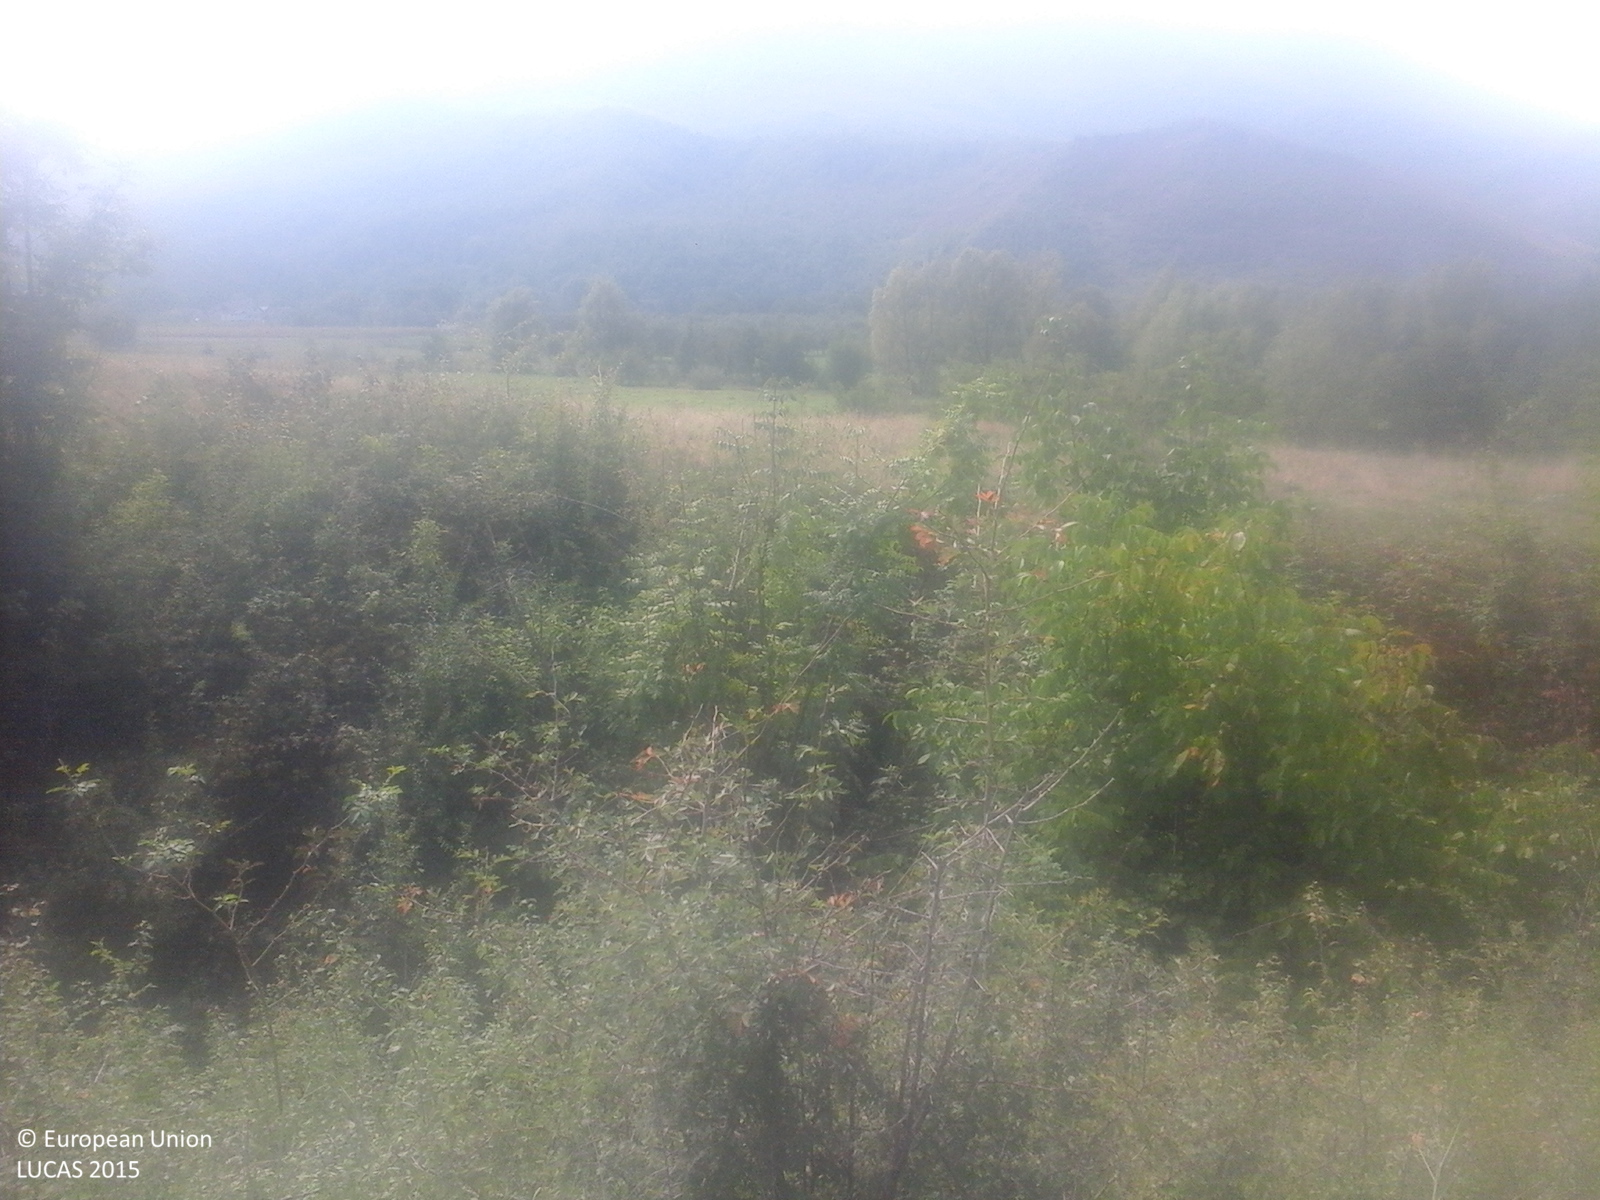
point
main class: Shrubland
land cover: Shrubland with sparse tree cover
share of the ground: > 75 %
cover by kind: herbaceous plants 65 %, shrubs 30 %, broadleaved forest trees 5 %
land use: Semi-natural and natural areas not in use
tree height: < 5 m
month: September
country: RO
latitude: 45.4981
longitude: 22.8607
